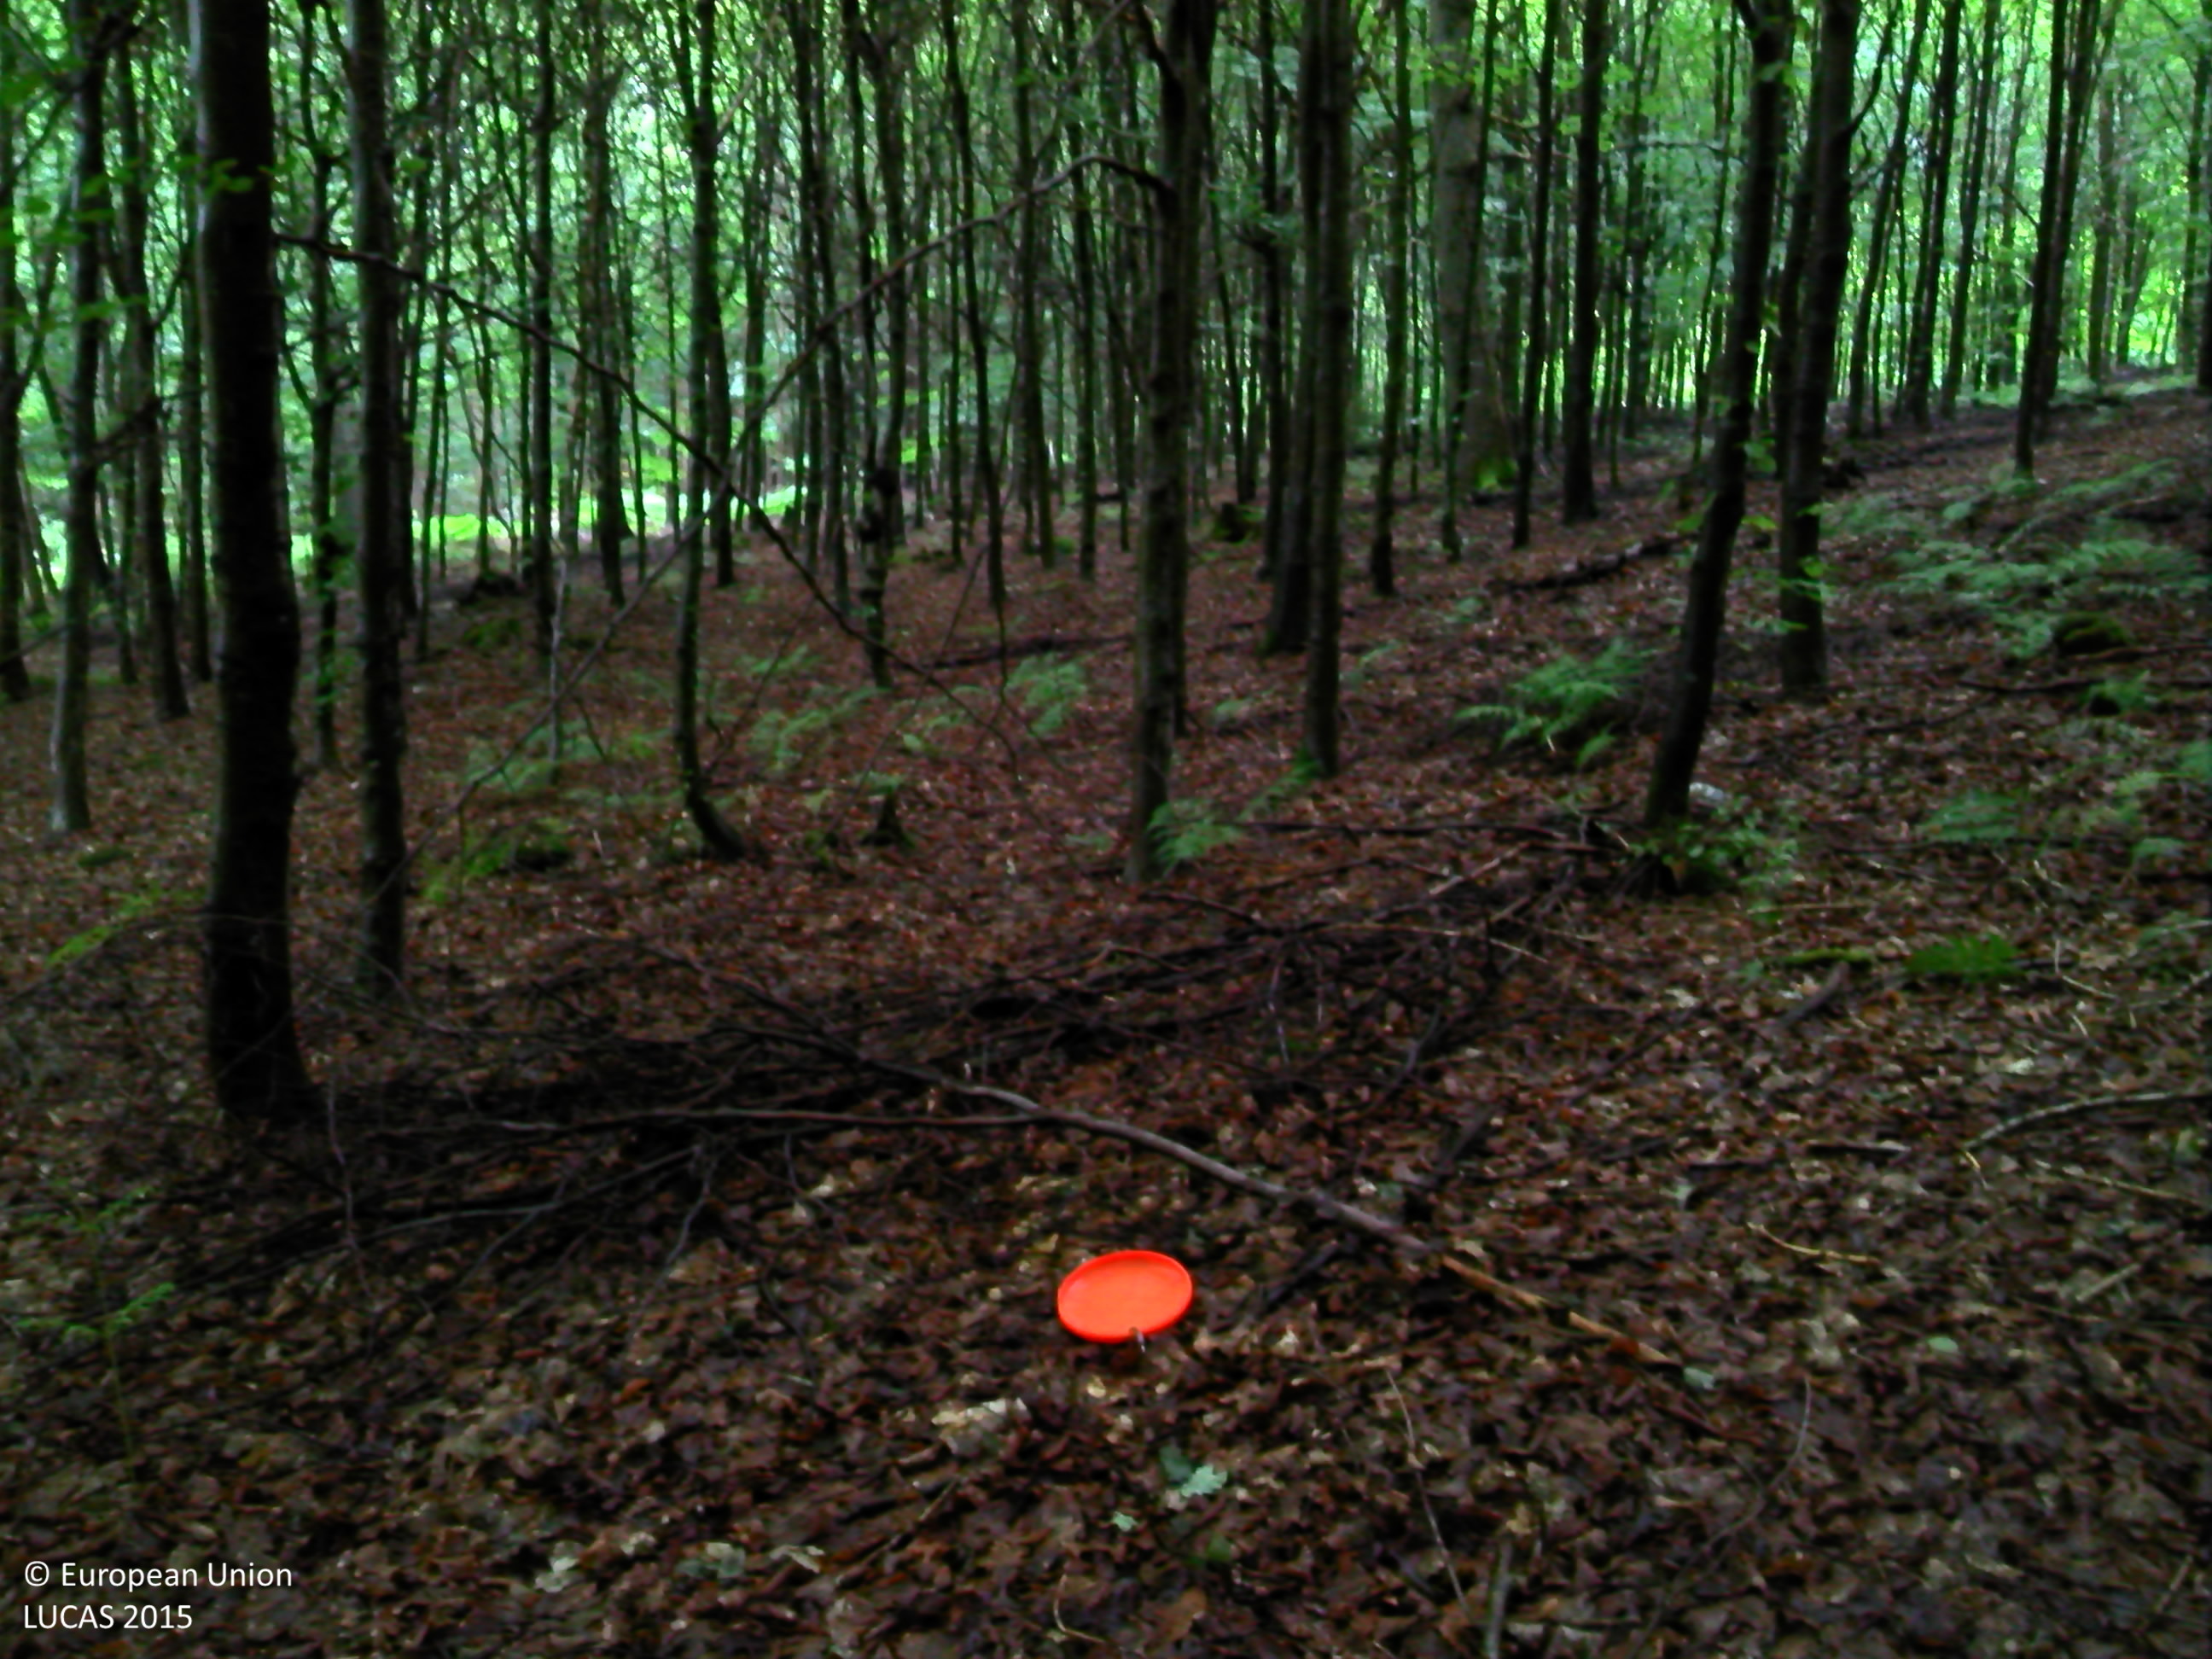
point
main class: Woodland
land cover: Broadleaved woodland
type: beech forest
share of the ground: > 75 %
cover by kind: broadleaved forest trees 90 %, herbaceous plants 5 %, lichens and mosses 5 %
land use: Forestry
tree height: > 5 m
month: July
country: BE
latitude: 50.4696
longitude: 5.8707
